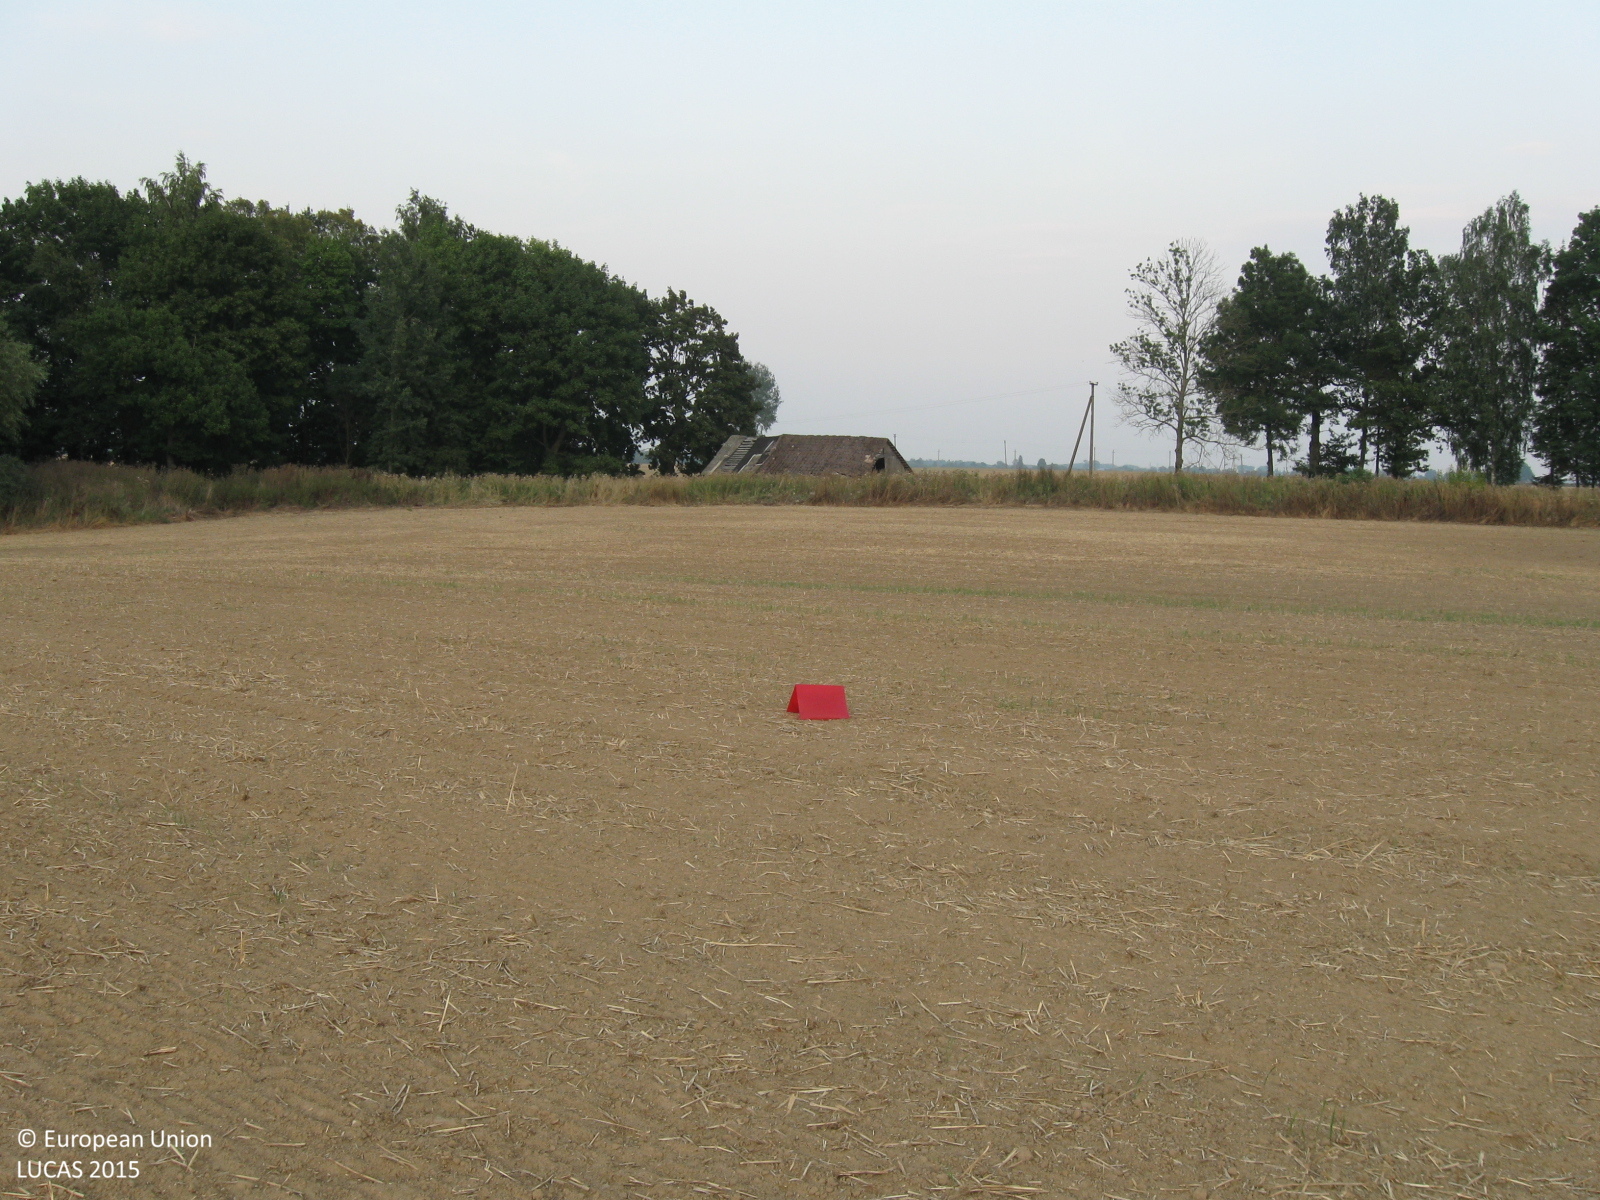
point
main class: Cropland
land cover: Common wheat
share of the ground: < 10 %
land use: Agriculture (excluding fallow land and kitchen gardens)
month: September
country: LT
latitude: 55.0661
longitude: 23.1807
